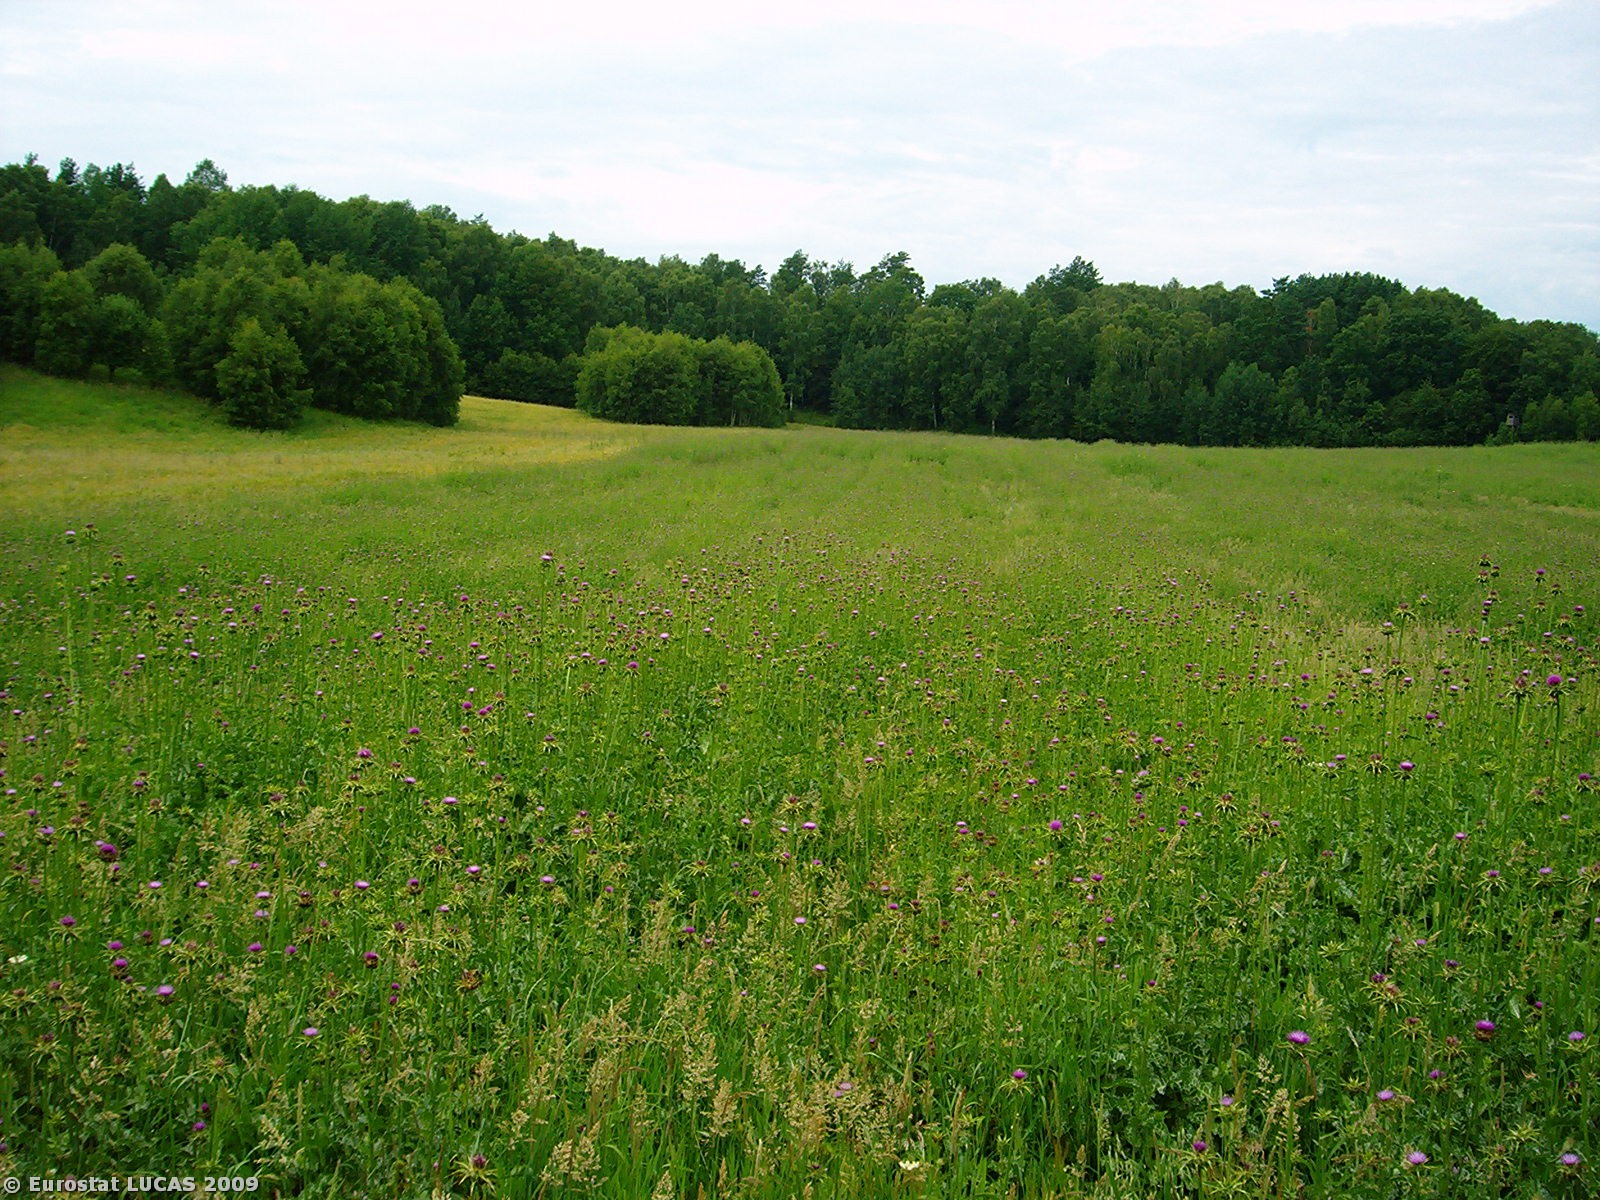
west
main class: Cropland
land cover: Other leguminous and mixtures for fodder
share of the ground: > 75 %
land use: Agriculture (excluding fallow land and kitchen gardens)
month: July
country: PL
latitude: 52.3823
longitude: 15.3660
